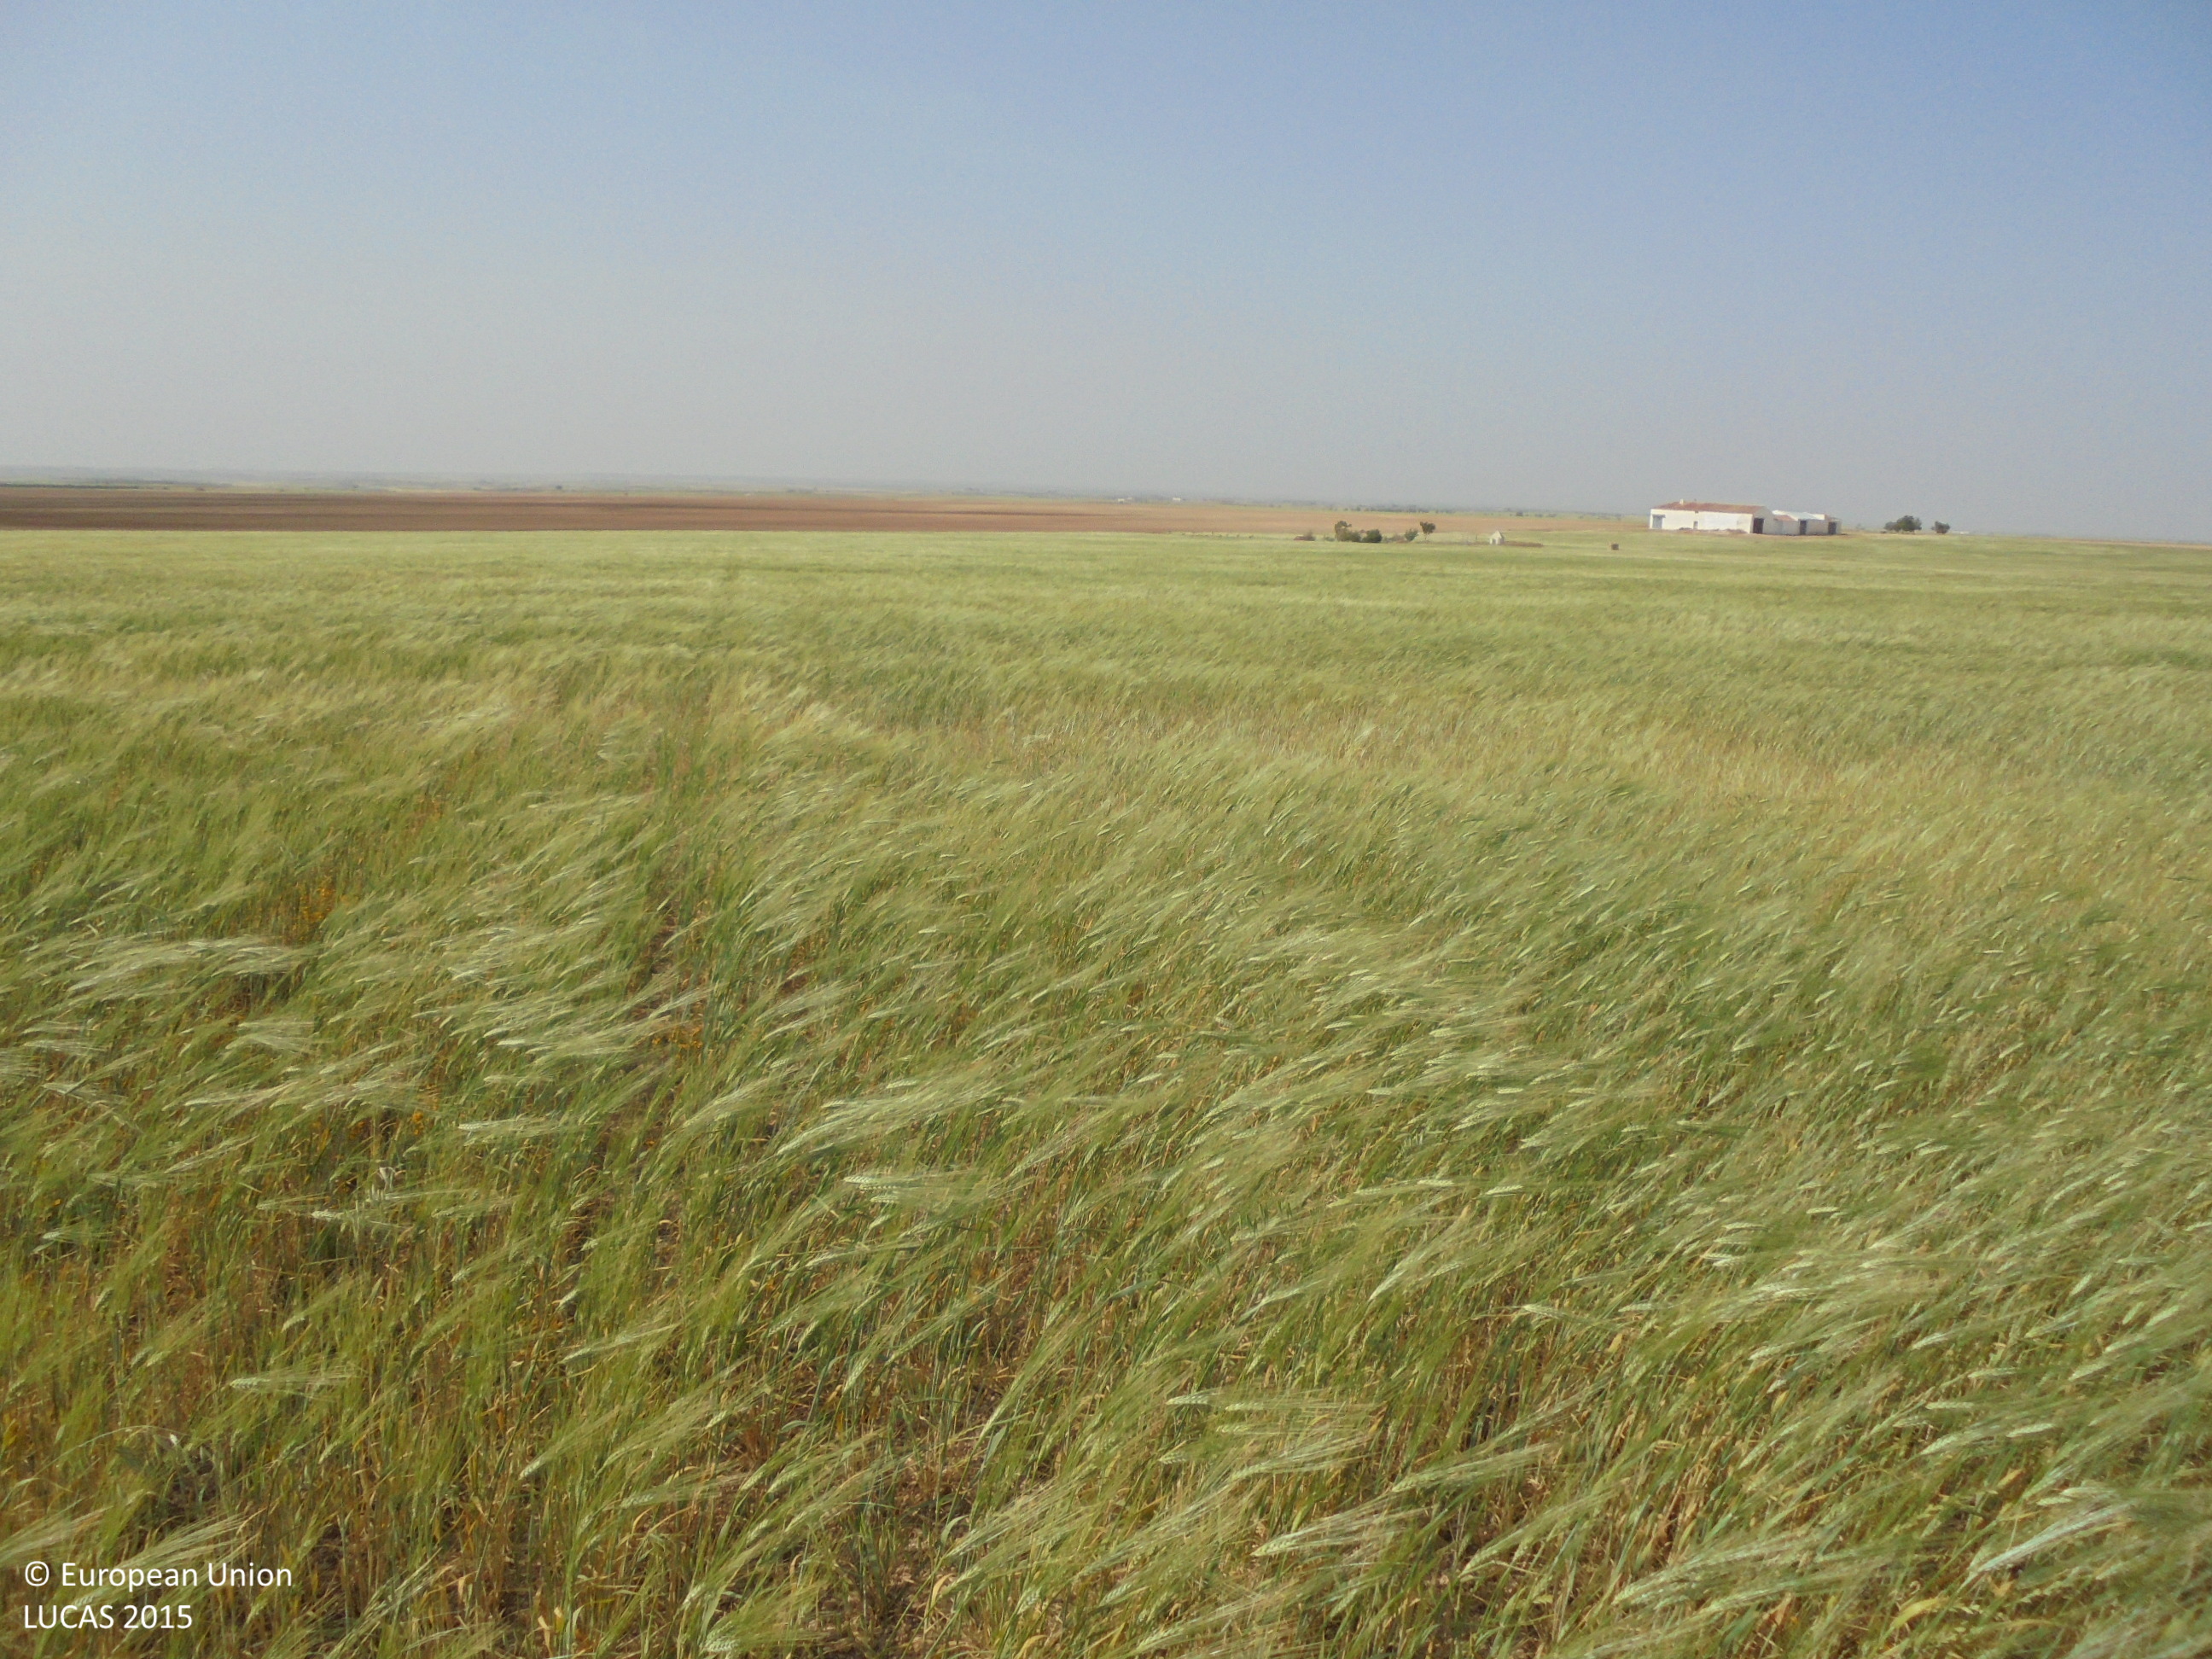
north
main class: Cropland
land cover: Barley
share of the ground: 25 - 50 %
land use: Agriculture (excluding fallow land and kitchen gardens)
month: May
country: ES
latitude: 39.0814
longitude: -1.6176
